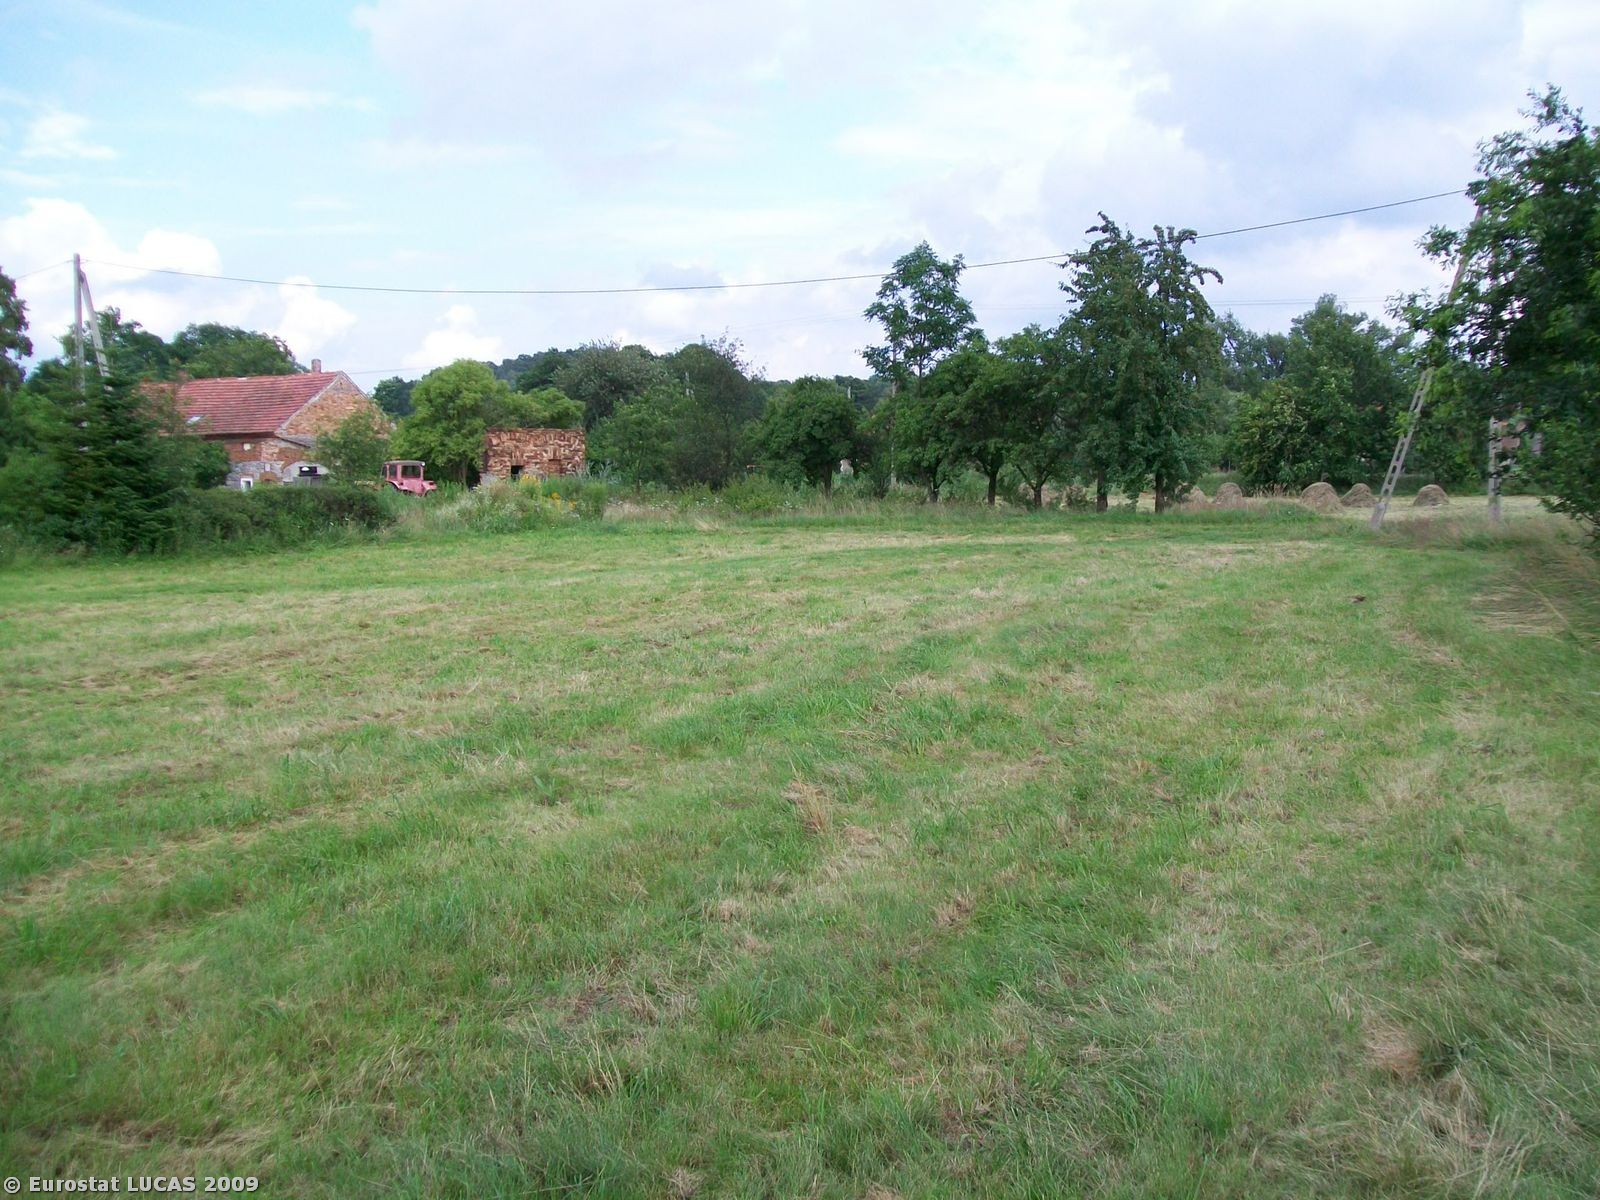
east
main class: Grassland
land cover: Grassland without tree/shrub cover
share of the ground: > 75 %
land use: Agriculture (excluding fallow land and kitchen gardens)
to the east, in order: Grassland without tree/shrub cover; Electric lines; Grassland without tree/shrub cover; Lines of trees; Artificial constructions in urban areas; Fences; Spontaneously vegetated surfaces; Abandoned hedges; Single bushes/trees; Spontaneously vegetated surfaces; Paved roads, cycling and walking lanes
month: July
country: PL
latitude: 51.1842
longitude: 15.1680
